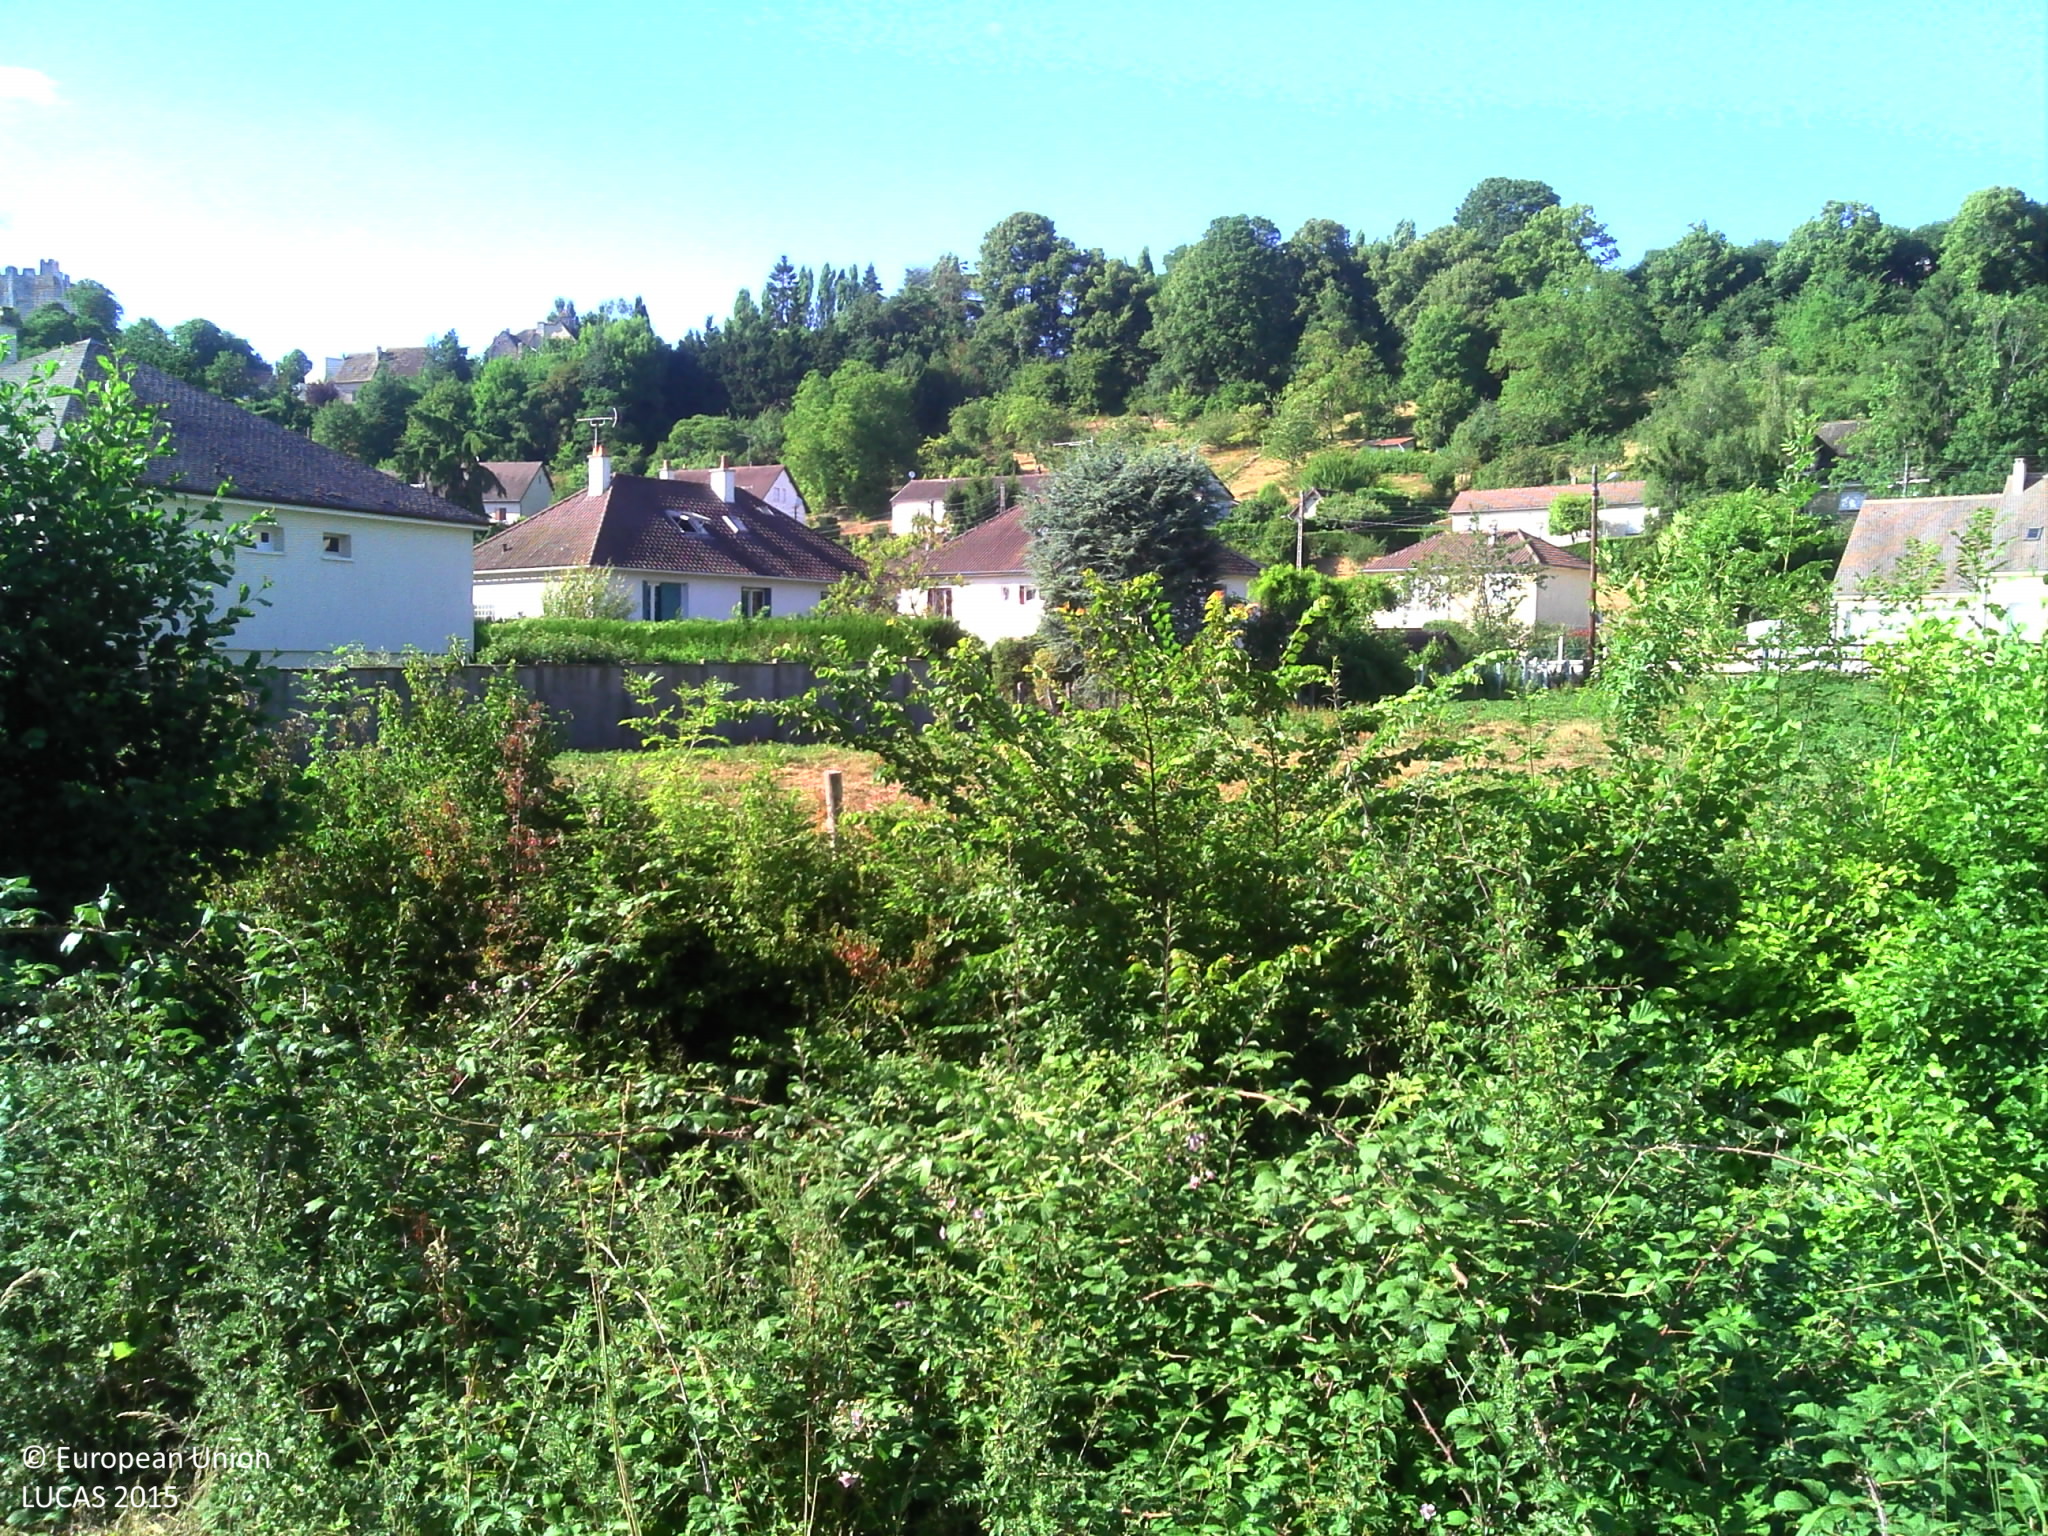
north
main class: Grassland
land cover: Grassland without tree/shrub cover
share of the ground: > 75 %
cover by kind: herbaceous plants 100 %
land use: Agriculture (excluding fallow land and kitchen gardens)
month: July
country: FR
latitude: 48.3109
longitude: 0.8231
